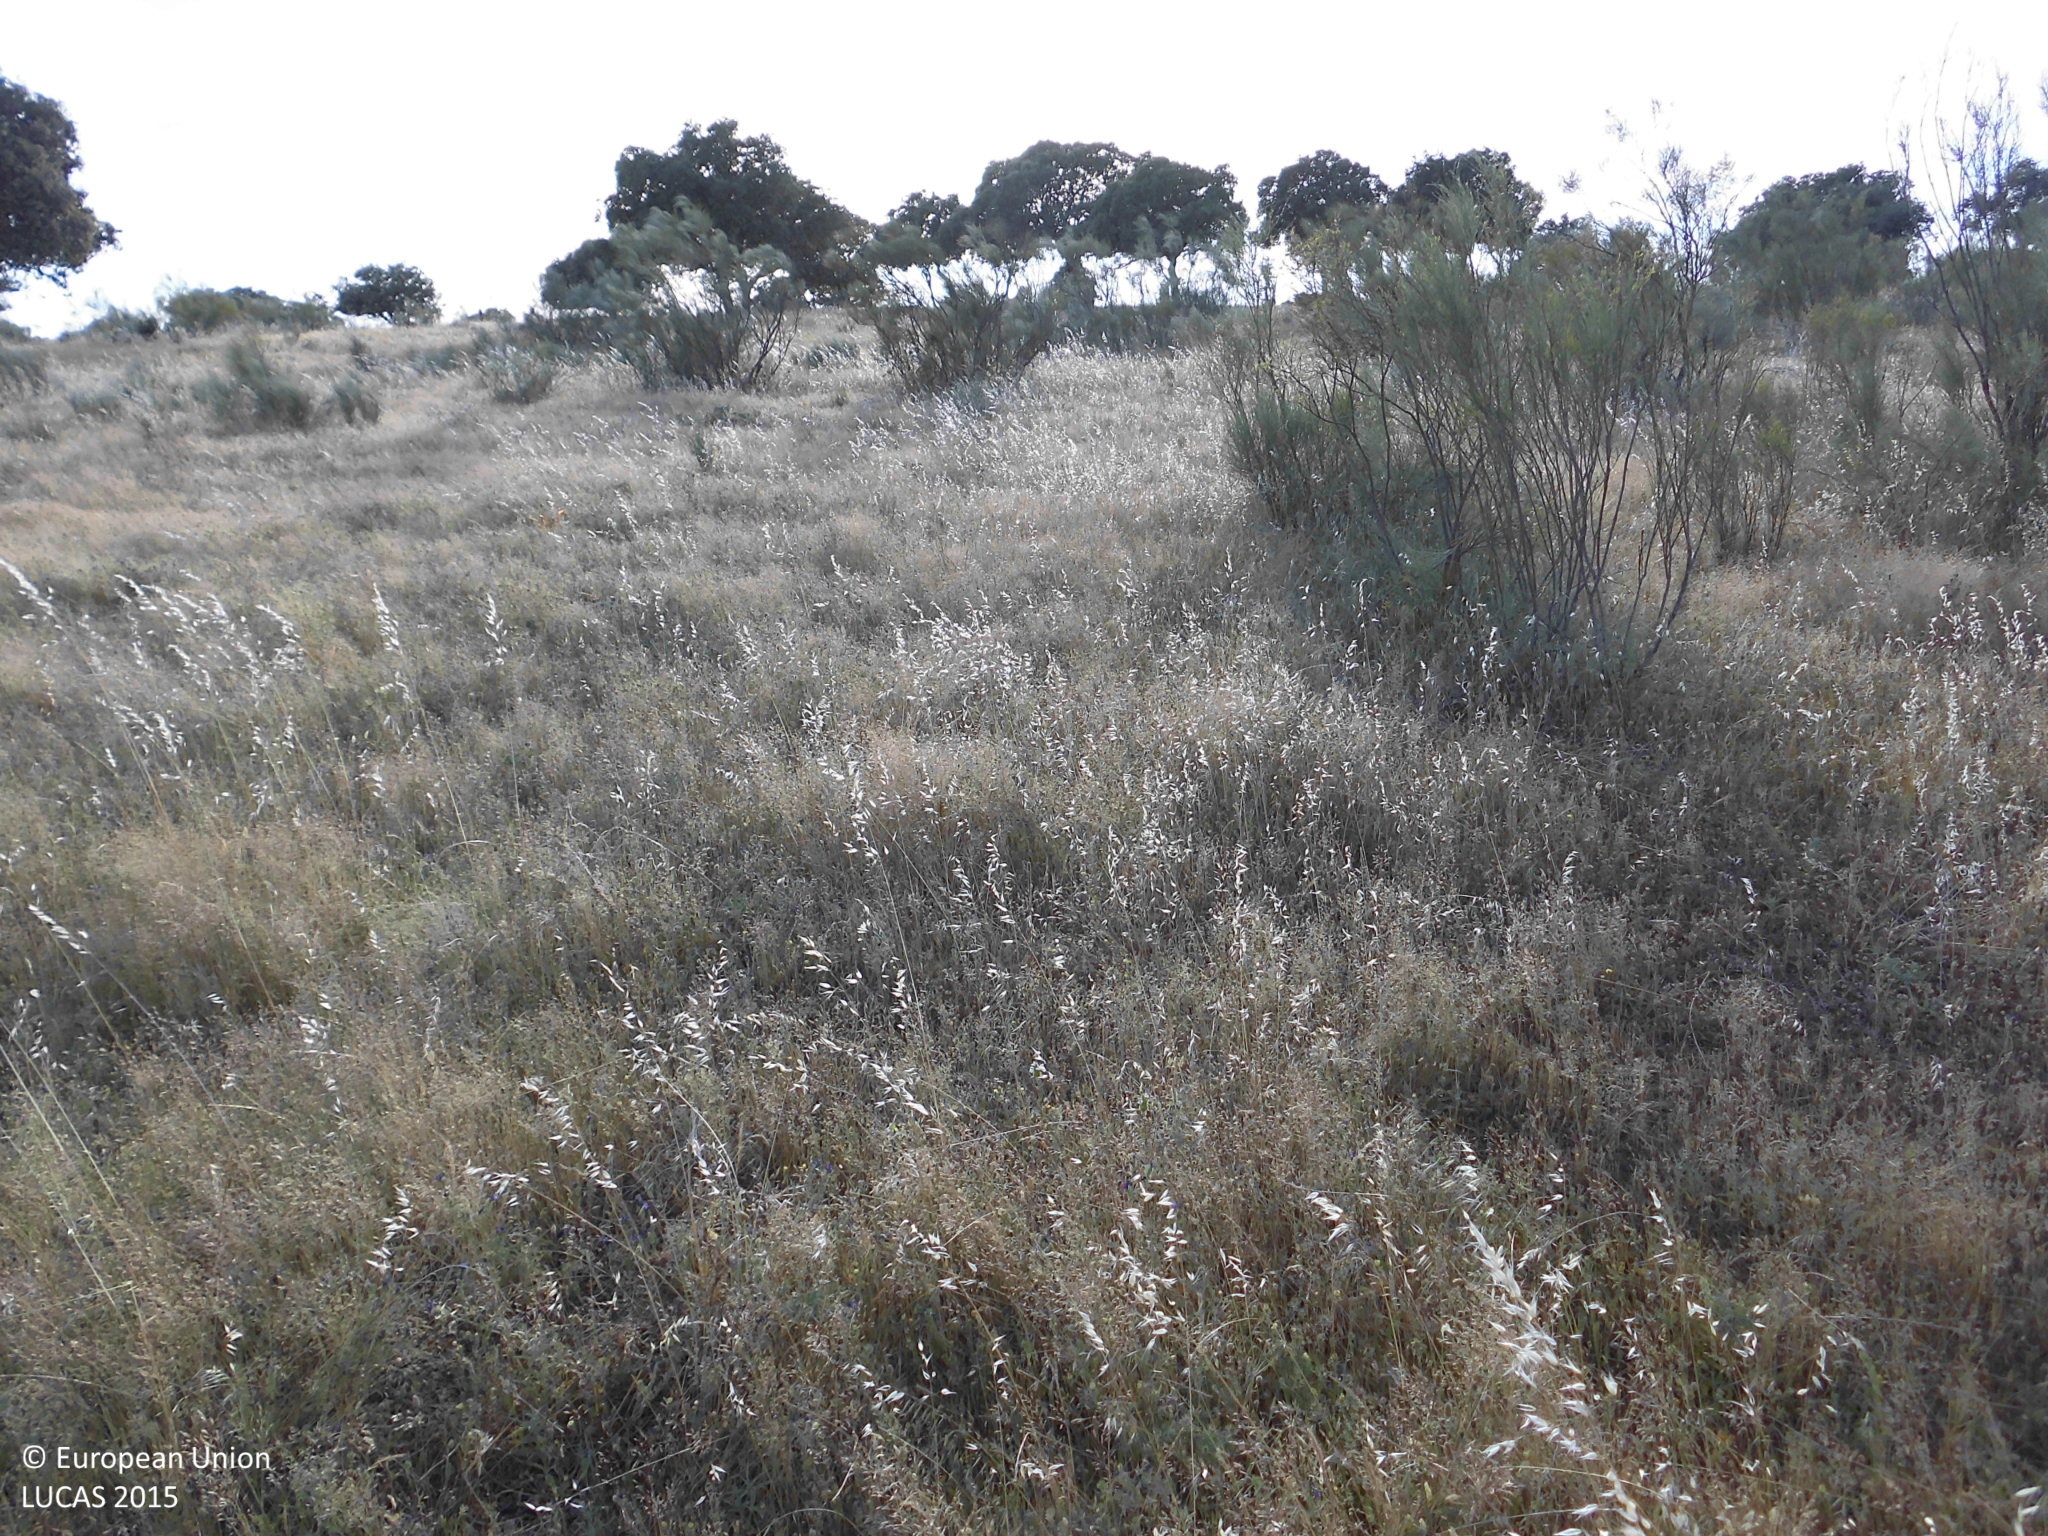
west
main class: Shrubland
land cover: Shrubland without tree cover
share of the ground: 10 - 25 %
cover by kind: herbaceous plants 90 %, shrubs 10 %
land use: Agriculture (excluding fallow land and kitchen gardens)
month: May
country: ES
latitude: 39.5693
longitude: -6.1167
